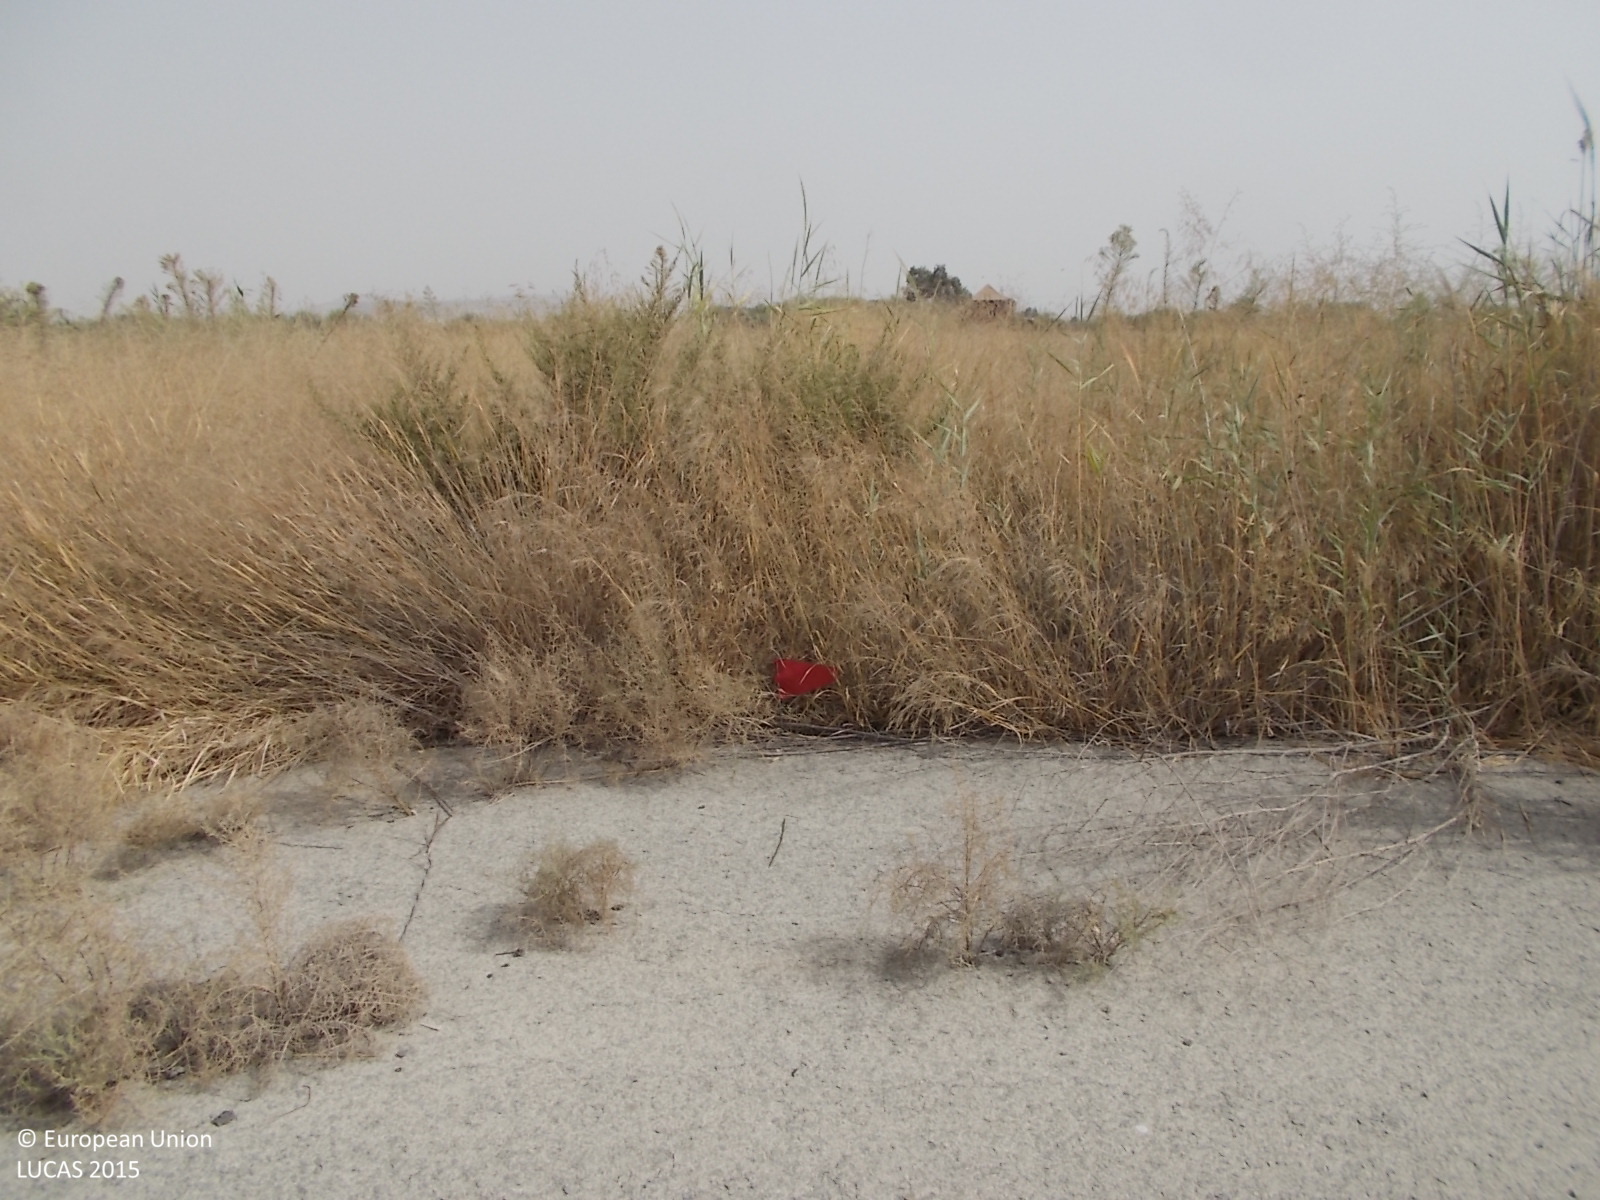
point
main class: Grassland
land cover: Spontaneously vegetated surfaces
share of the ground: > 75 %
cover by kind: herbaceous plants 100 %
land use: Abandoned areas
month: April
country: CY
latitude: 34.9468
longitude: 33.6412
